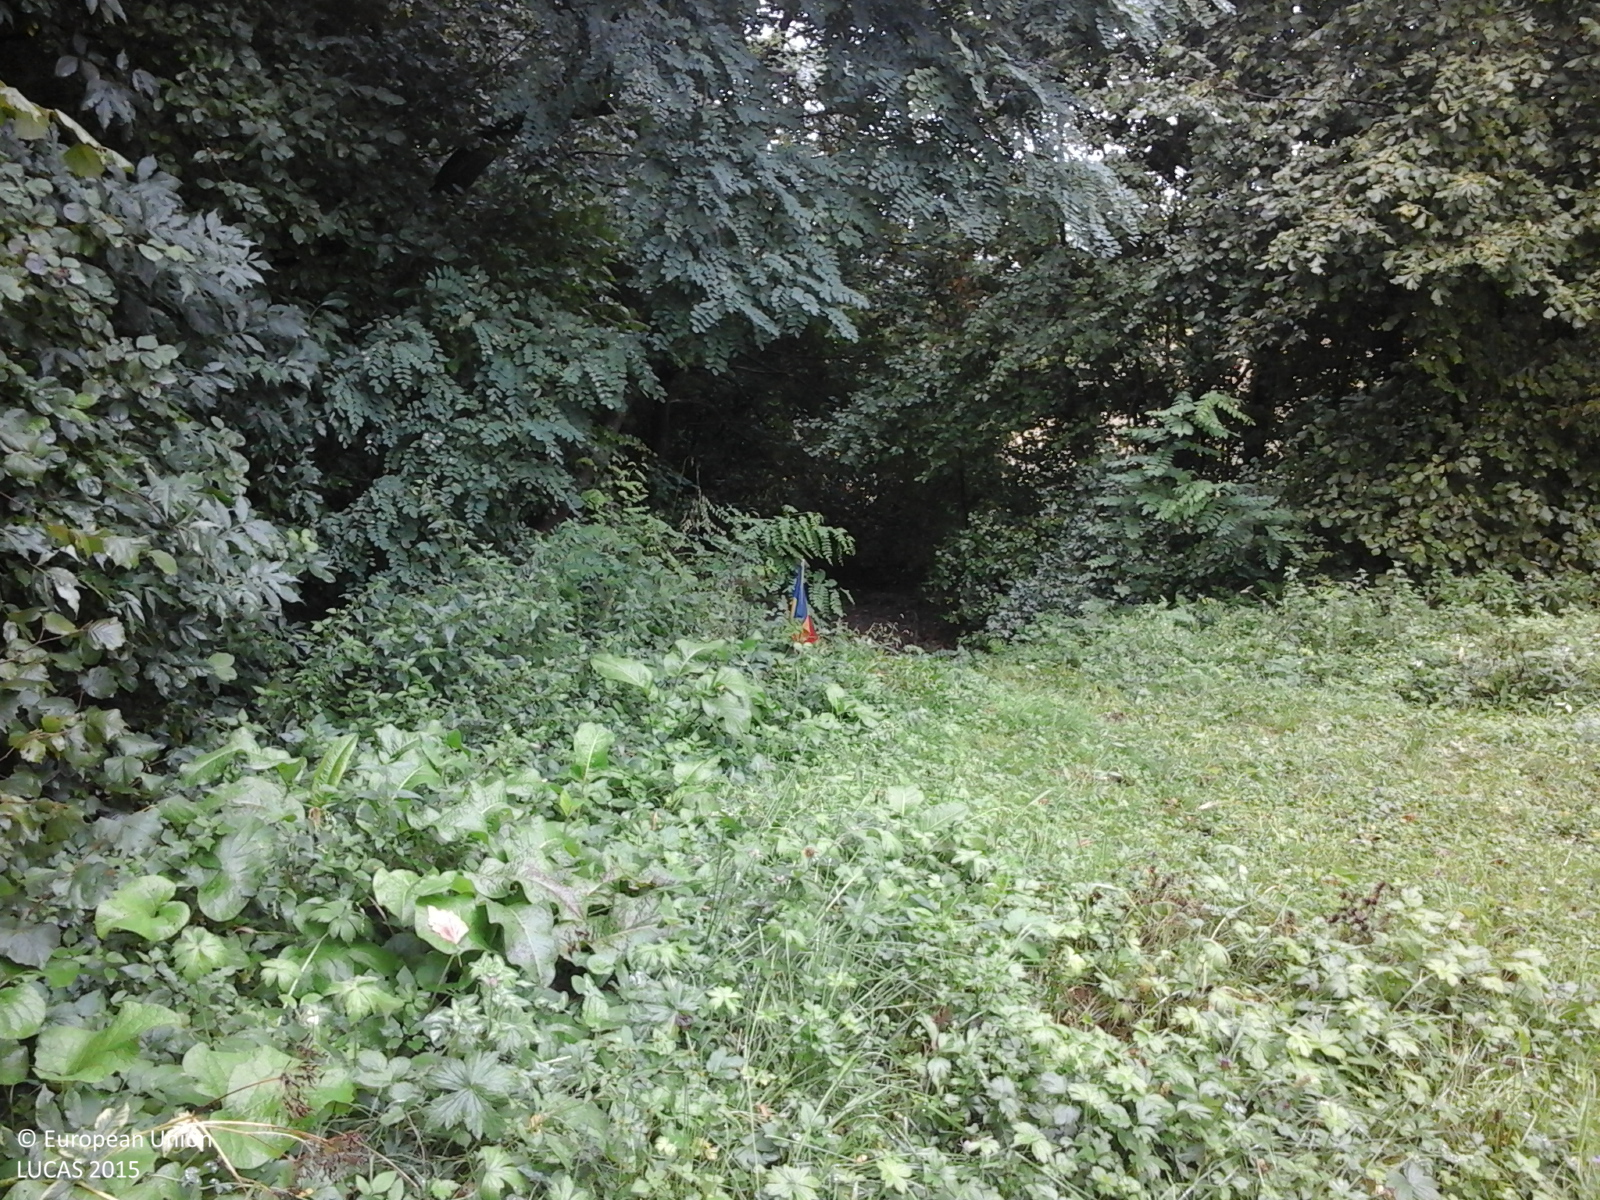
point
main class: Woodland
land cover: Broadleaved woodland
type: exotic forest
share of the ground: > 75 %
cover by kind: broadleaved forest trees 100 %
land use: Forestry
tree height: > 5 m
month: September
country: RO
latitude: 47.0304
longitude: 22.5426
